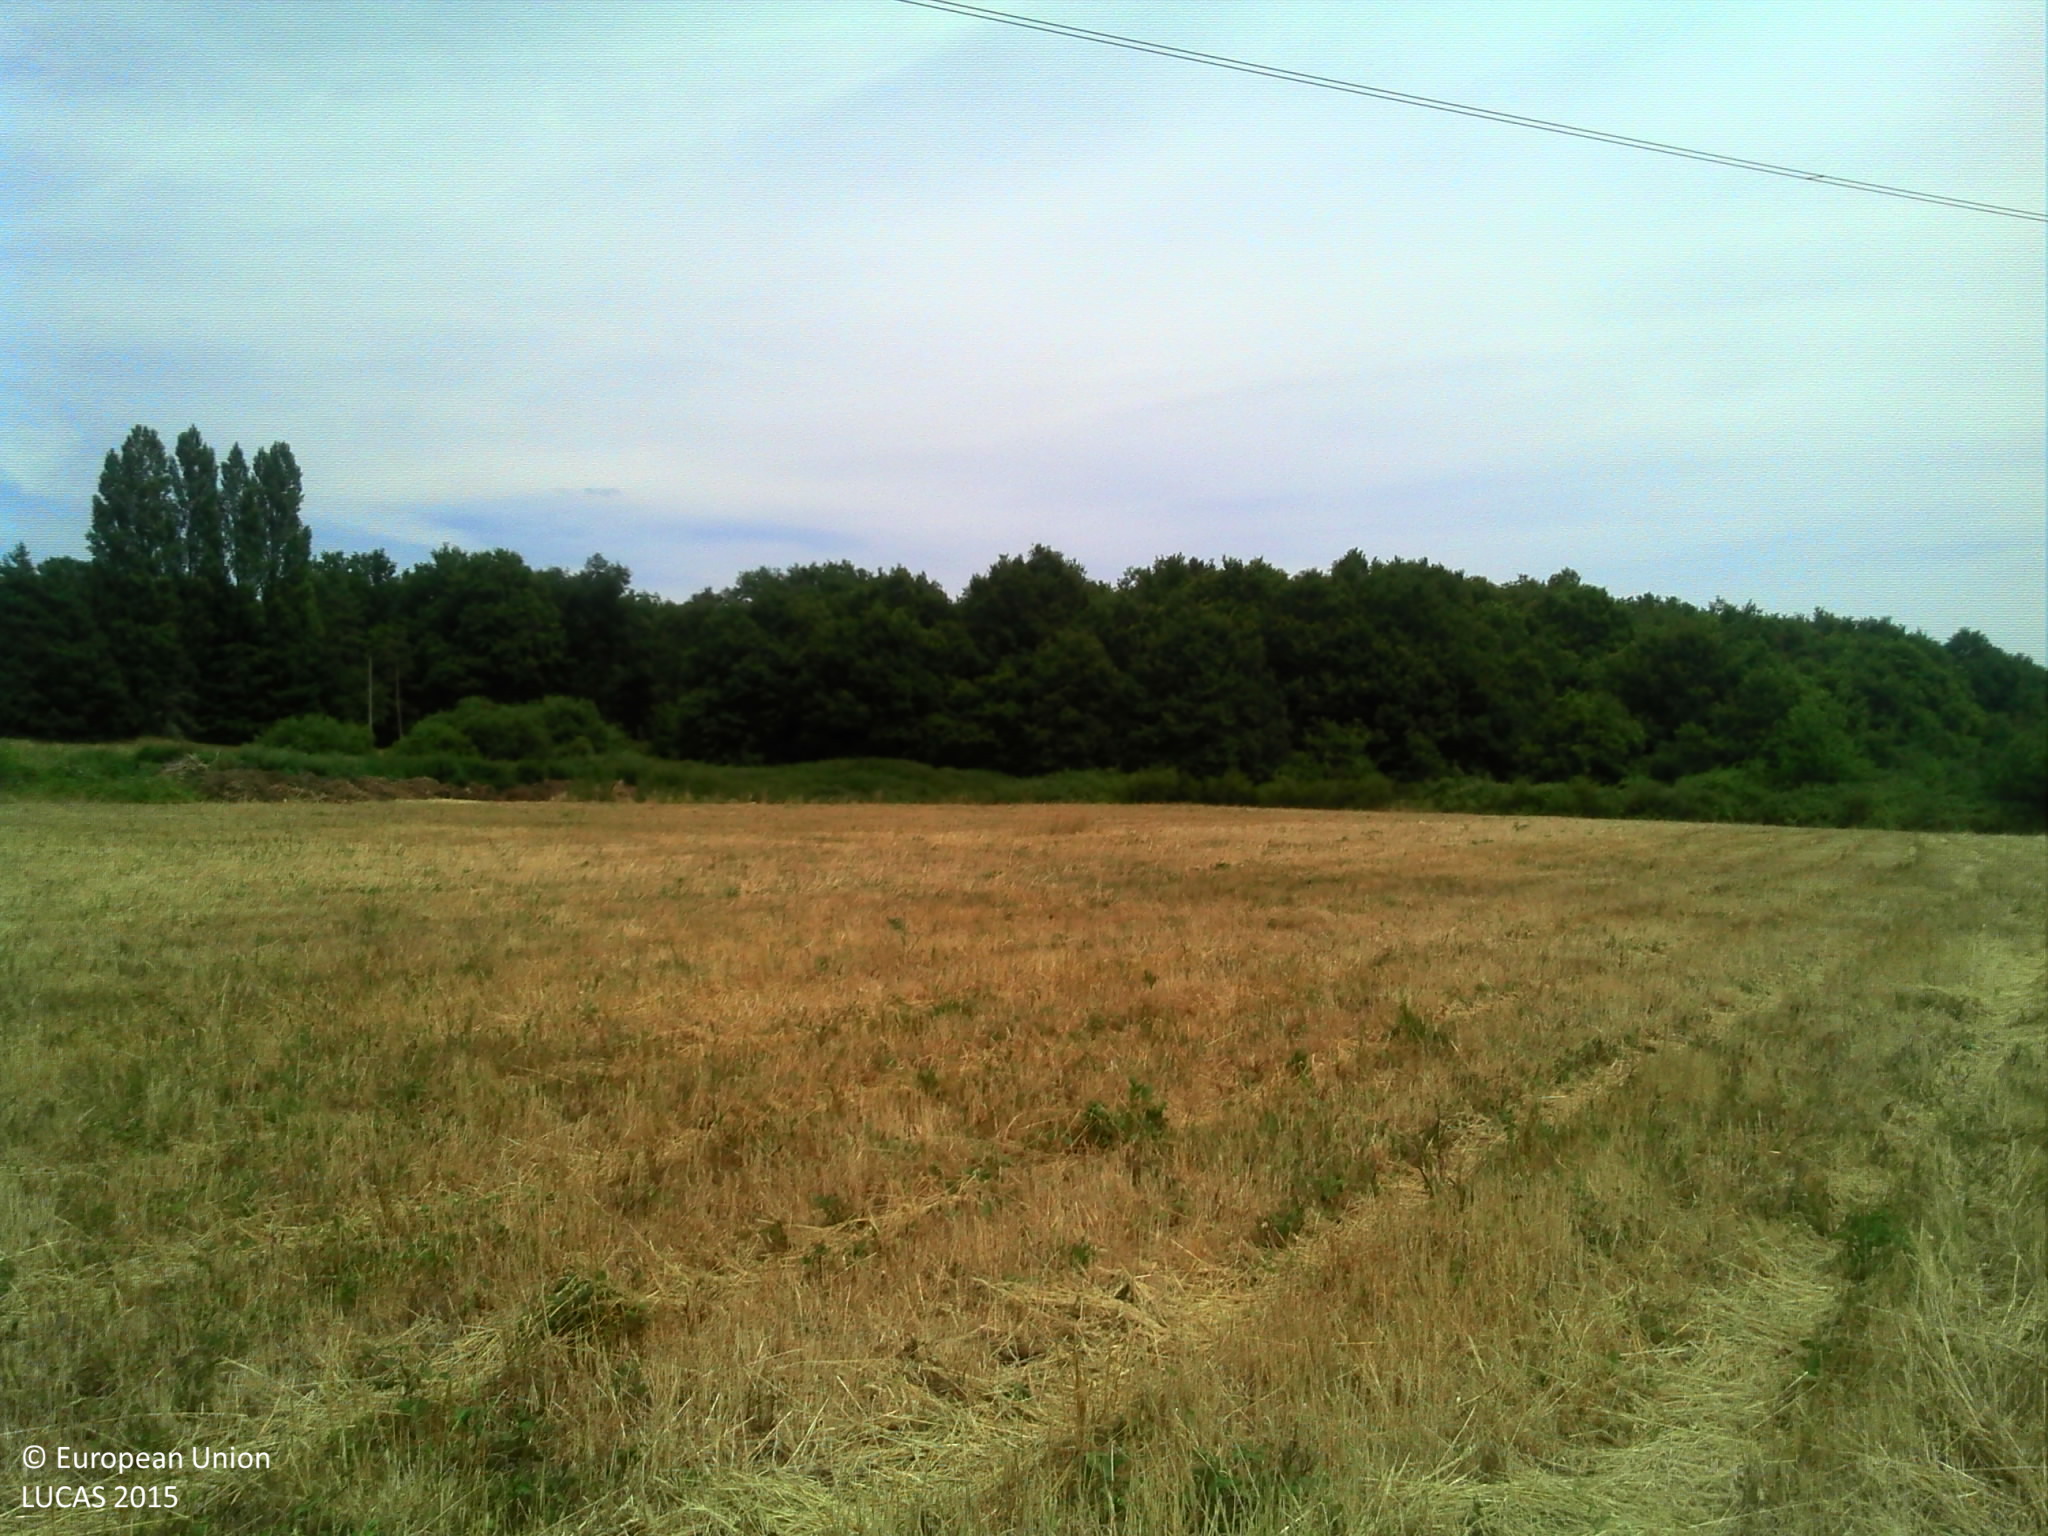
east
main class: Grassland
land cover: Grassland without tree/shrub cover
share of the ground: > 75 %
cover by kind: herbaceous plants 100 %
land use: Agriculture (excluding fallow land and kitchen gardens)
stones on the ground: < 10 %
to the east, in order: Grassland without tree/shrub cover; Electric lines; Grassland without tree/shrub cover; Tracks; Grassland without tree/shrub cover; Broadleaved woodland; Fences; Grass margins; Paved roads, cycling and walking lanes; Grass margins; Ditches and canals; Fences; Electric lines; Broadleaved woodland
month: June
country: FR
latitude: 47.7355
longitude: 2.5373
